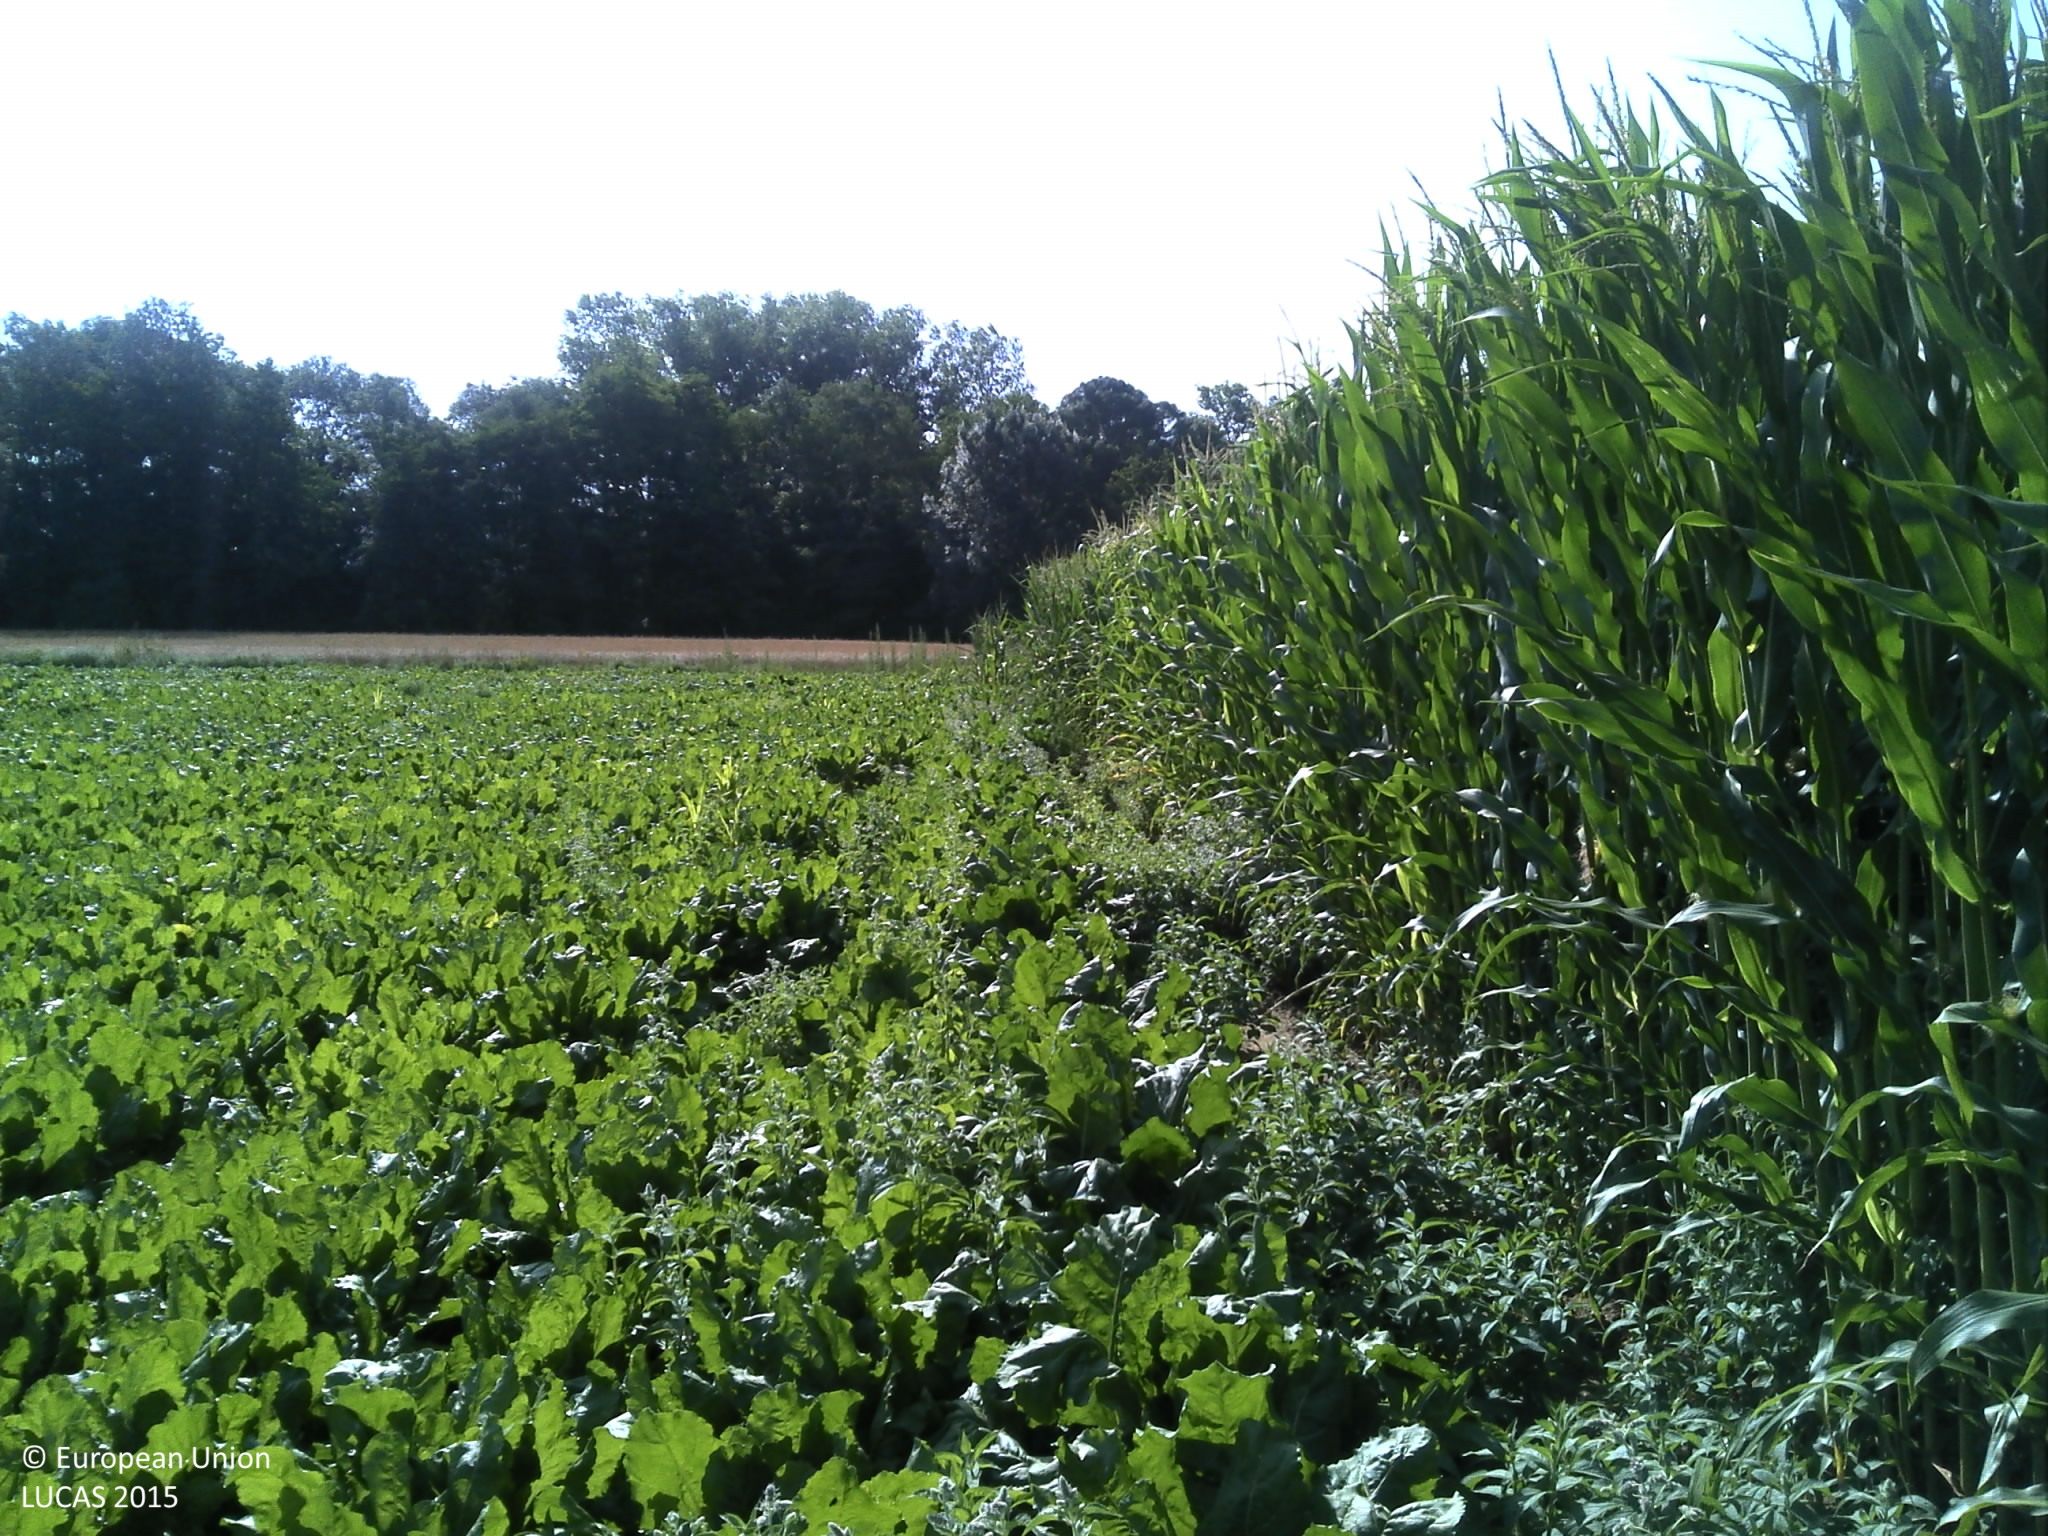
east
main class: Cropland
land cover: Maize
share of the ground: > 75 %
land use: Agriculture (excluding fallow land and kitchen gardens)
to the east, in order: Maize; Grass margins; Sugar beet
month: July
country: FR
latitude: 45.8708
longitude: 3.3141
